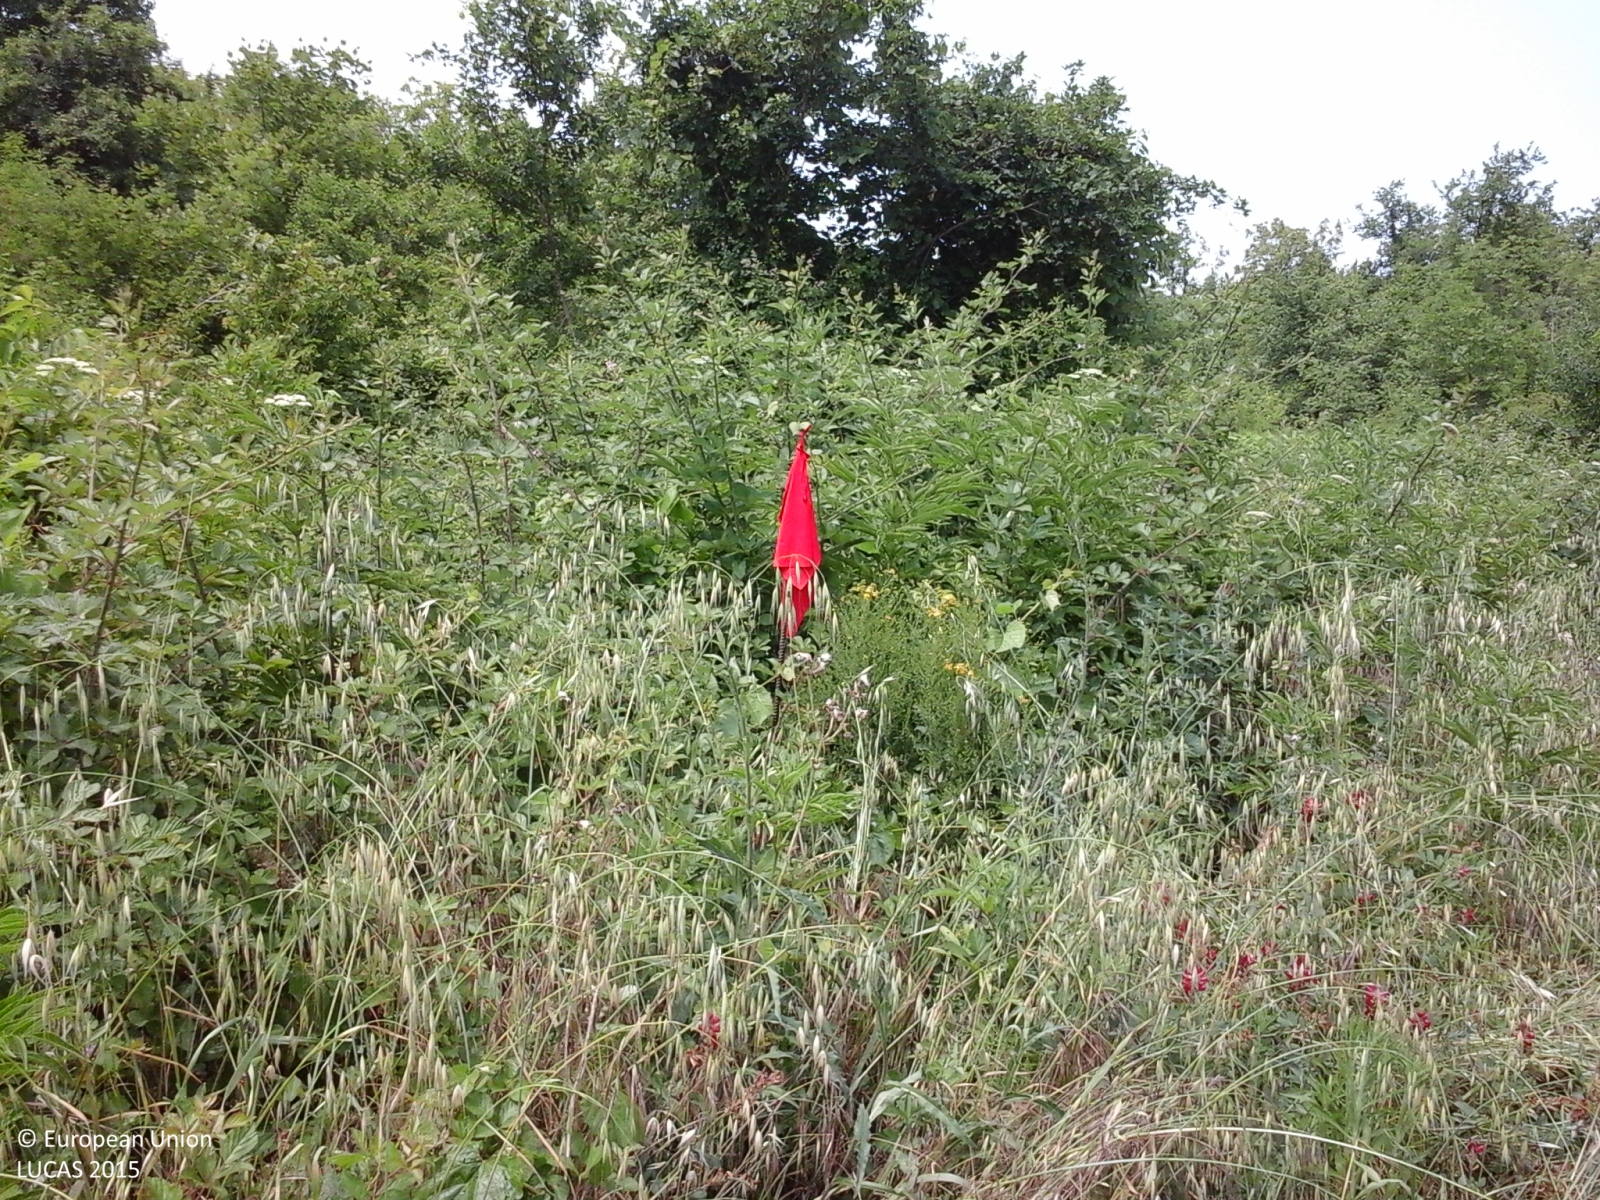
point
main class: Shrubland
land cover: Shrubland with sparse tree cover
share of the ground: > 75 %
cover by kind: shrubs 90 %, broadleaved forest trees 5 %, herbaceous plants 5 %
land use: Semi-natural and natural areas not in use
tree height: < 5 m
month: June
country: IT
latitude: 42.0701
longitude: 14.3975
